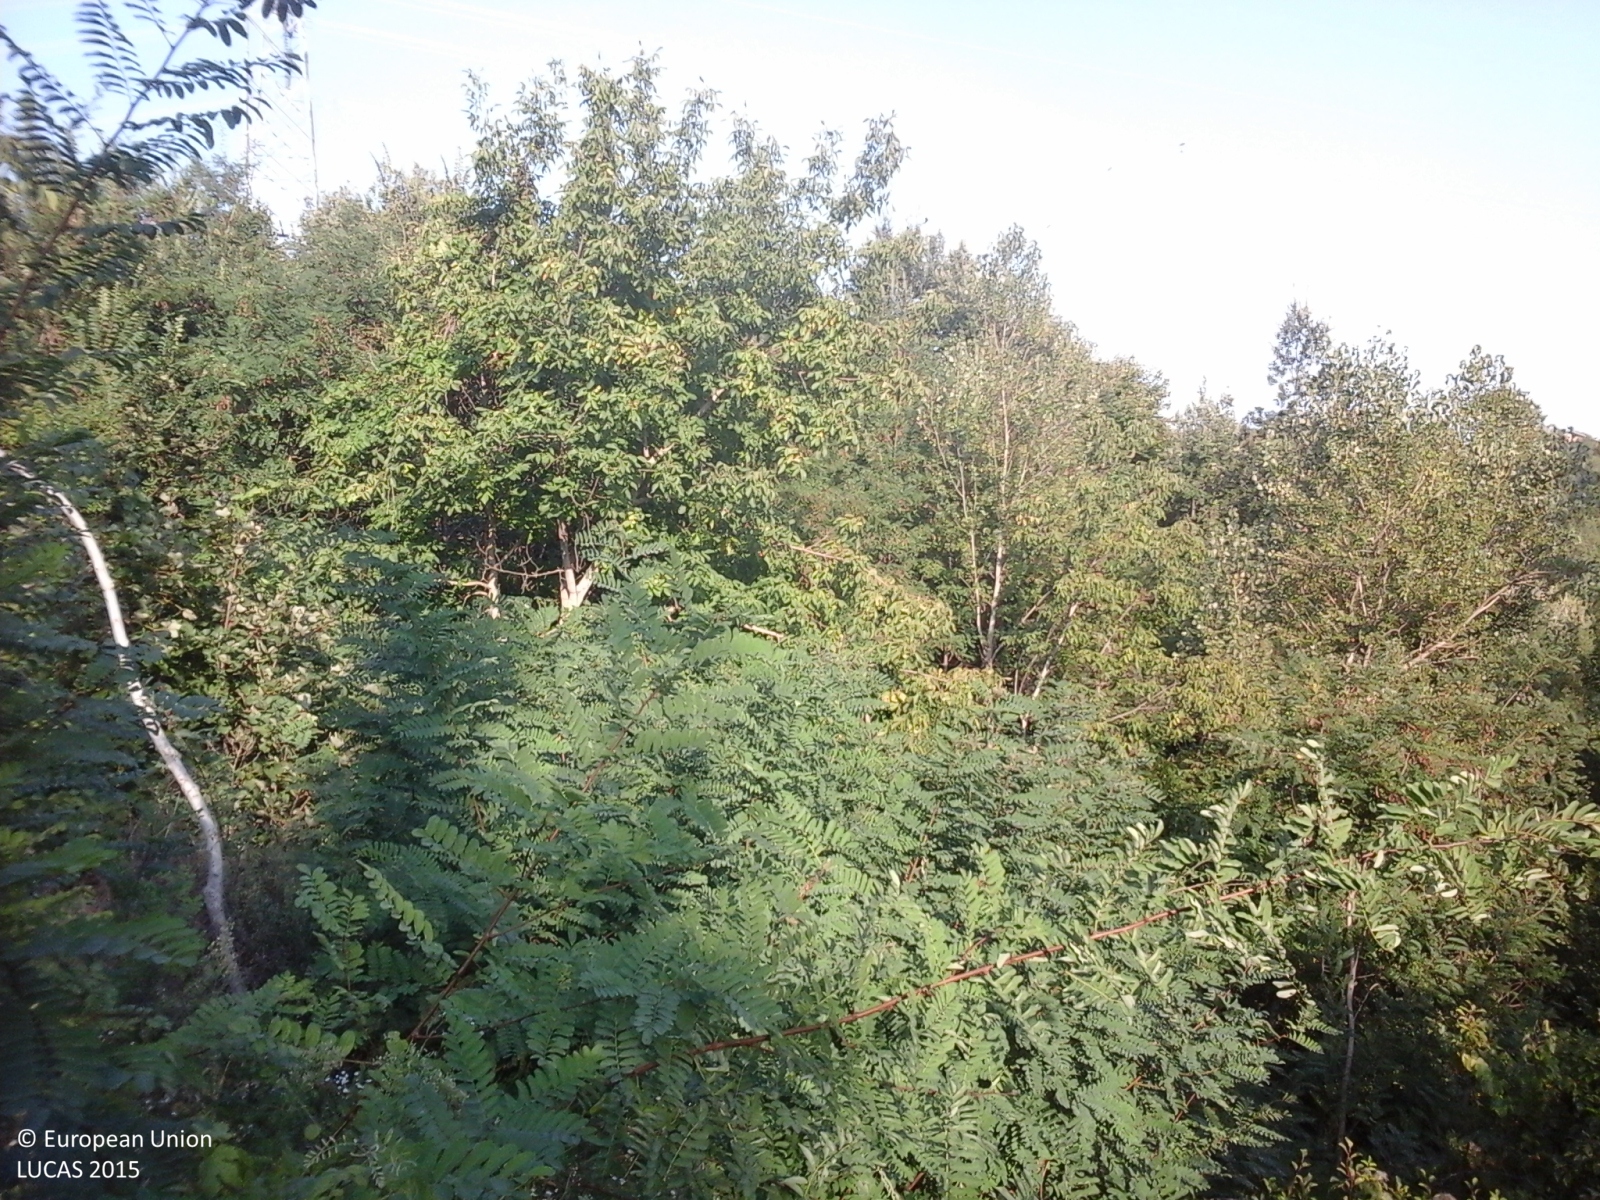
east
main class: Woodland
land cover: Broadleaved woodland
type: thermophilous deciduous forest
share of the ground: > 75 %
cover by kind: broadleaved forest trees 100 %
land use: Semi-natural and natural areas not in use
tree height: > 5 m
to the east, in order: Broadleaved woodland; Electric lines; Broadleaved woodland; Olive groves; Artificial constructions in urban areas; Broadleaved woodland; Electric lines; Broadleaved woodland
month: August
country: IT
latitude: 42.9941
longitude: 13.4126
